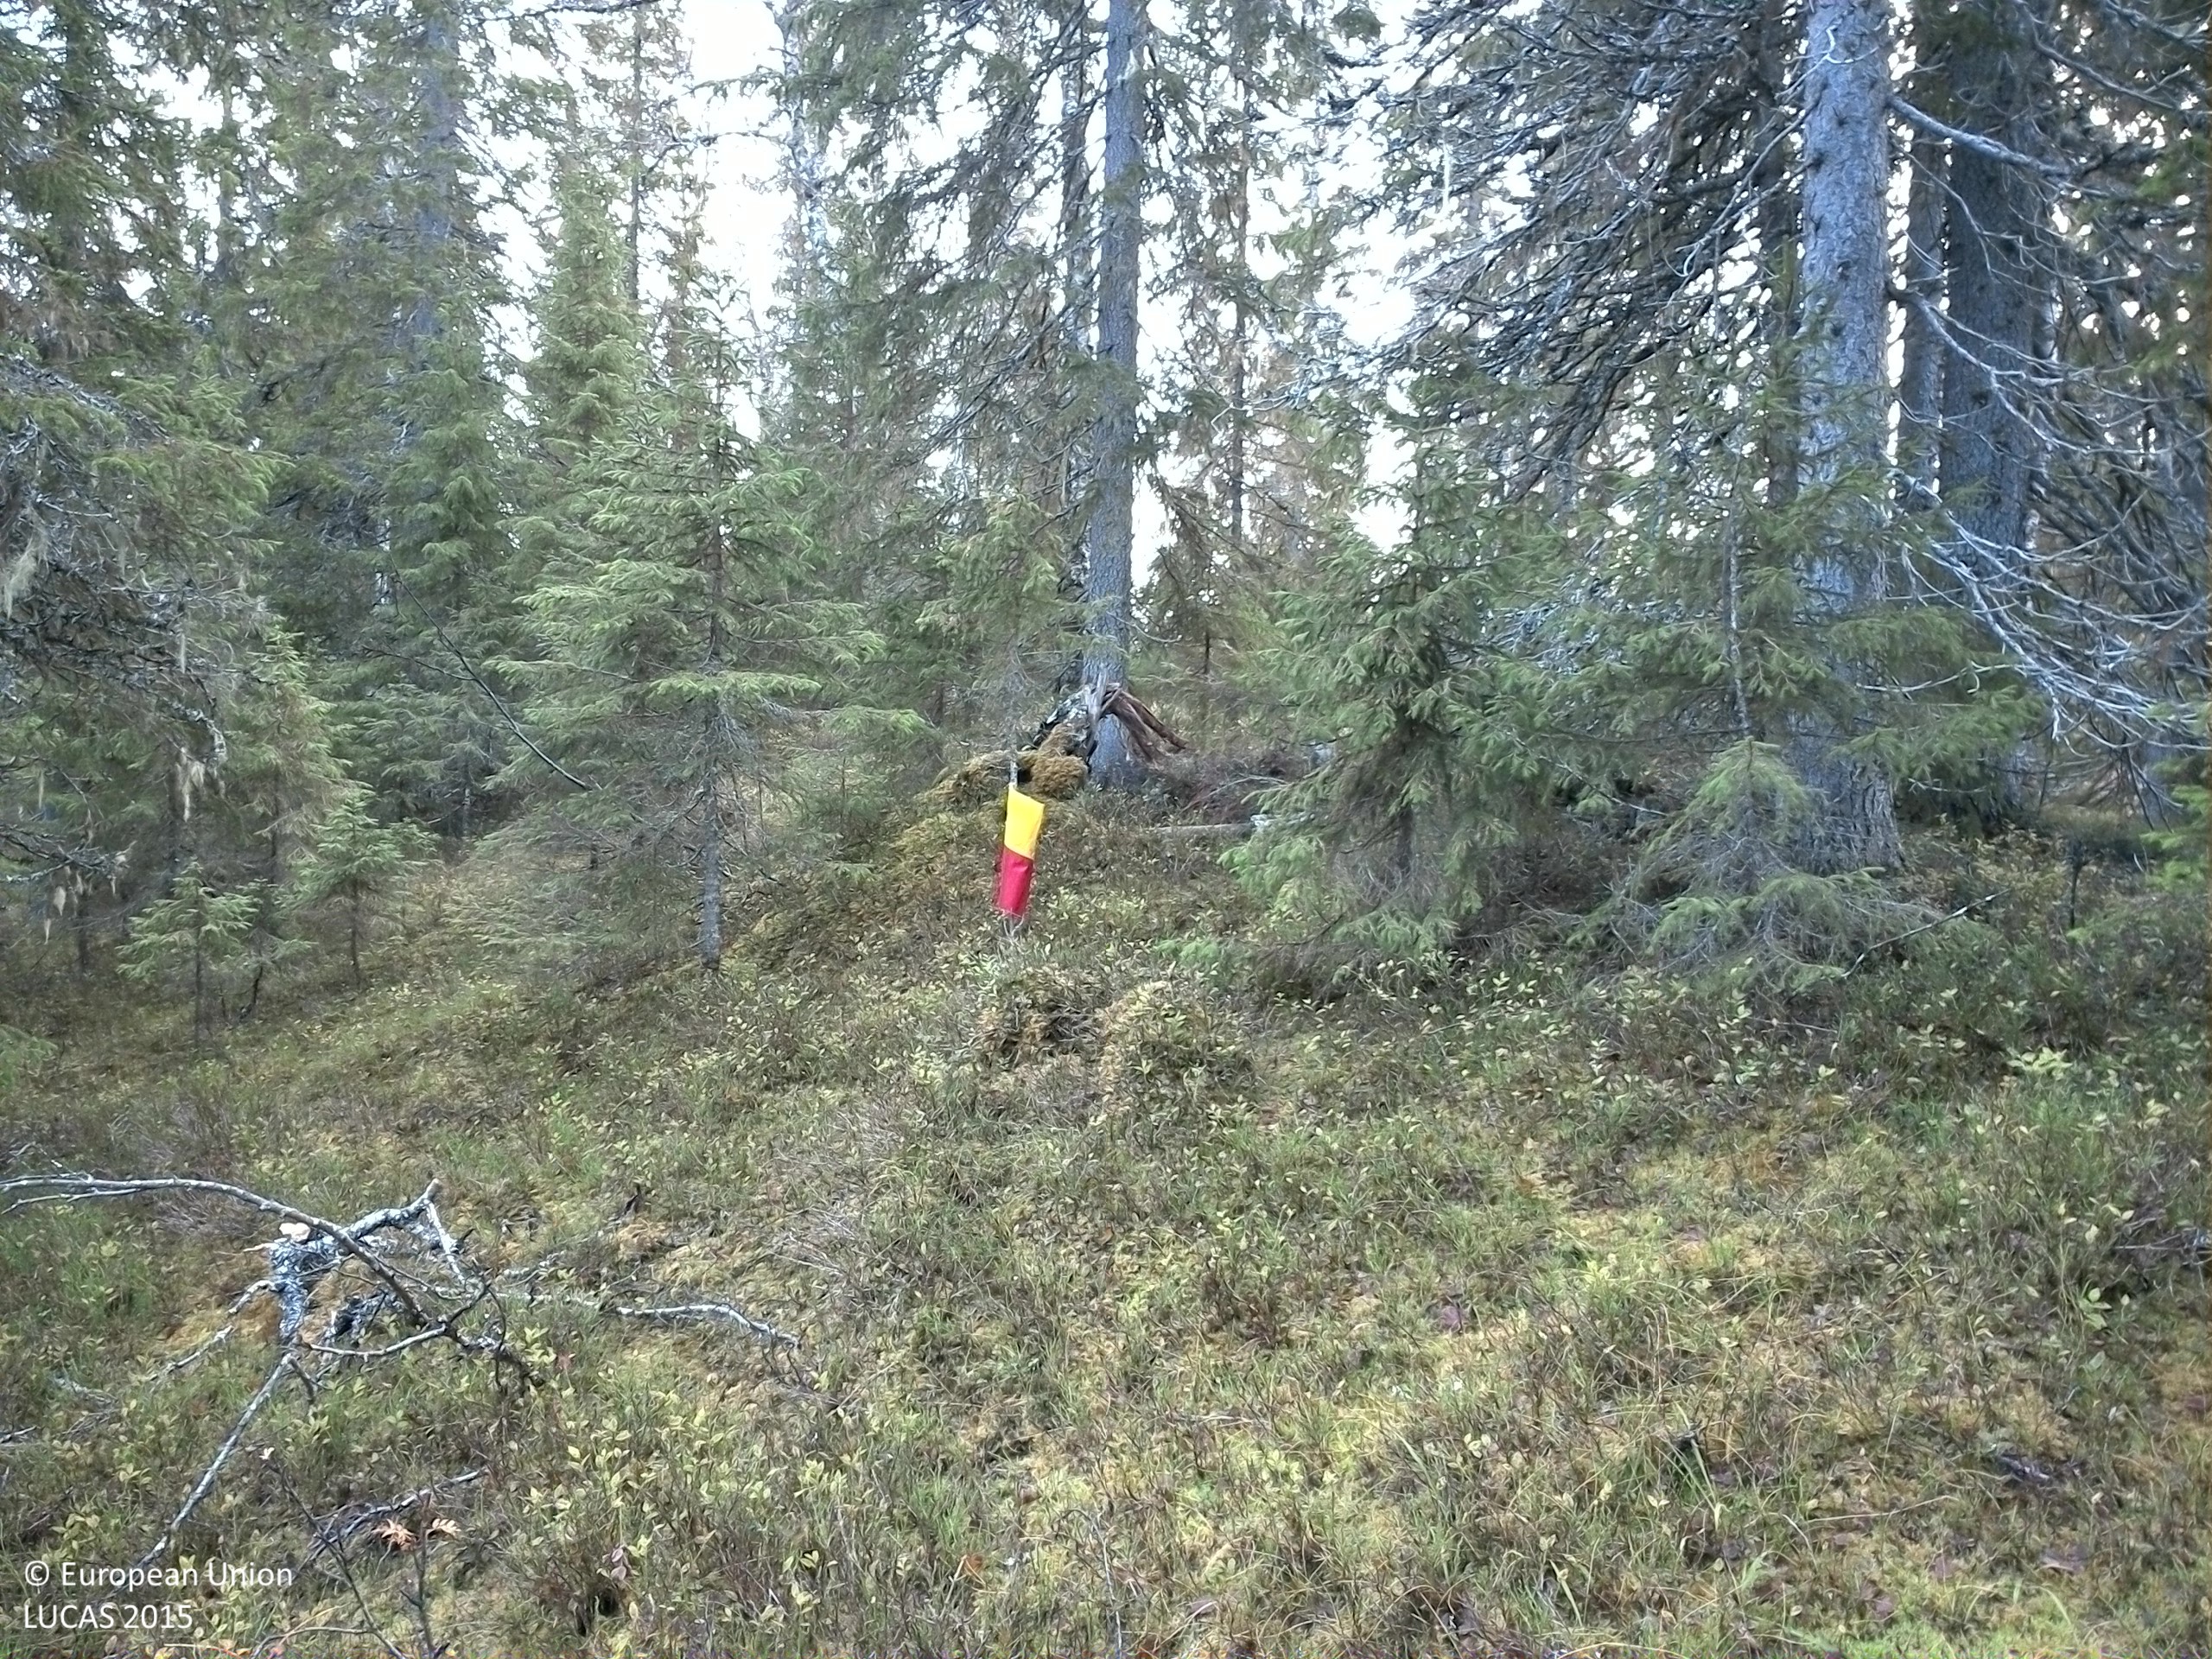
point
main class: Woodland
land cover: Spruce dominated coniferous woodland
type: boreal forest
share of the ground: 25 - 50 %
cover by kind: coniferous forest trees 40 %, shrubs 40 %, lichens and mosses 15 %, broadleaved forest trees 5 %
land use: Forestry
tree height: > 5 m
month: October
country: SE
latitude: 64.6196
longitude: 13.9694
